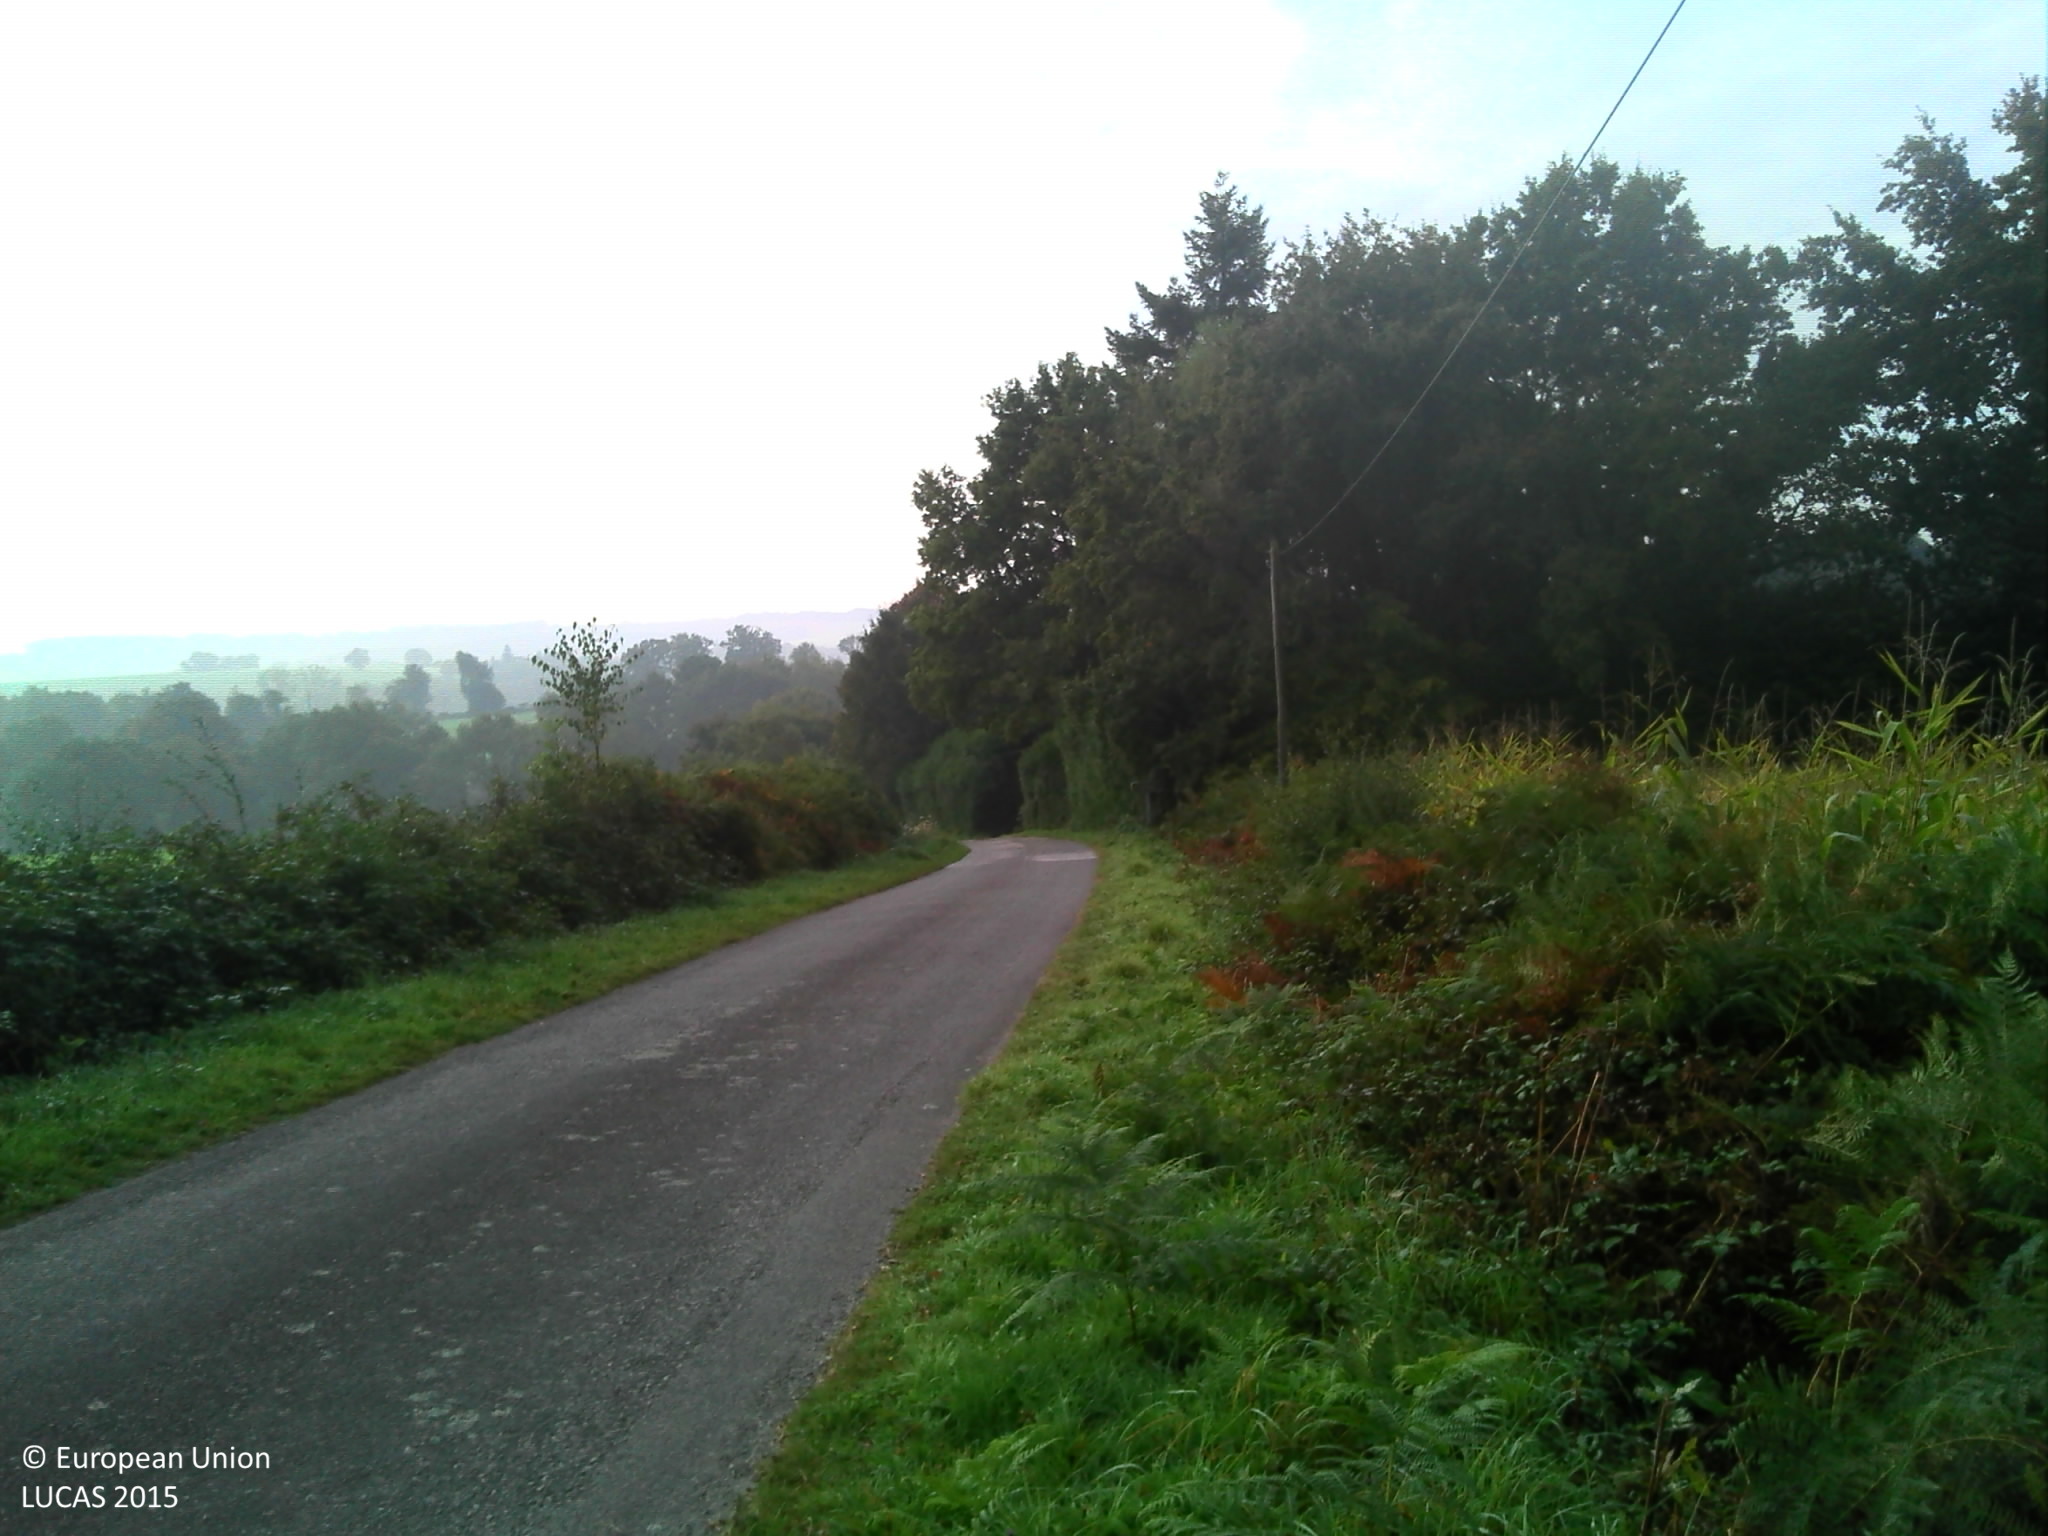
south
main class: Cropland
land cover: Maize
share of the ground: > 75 %
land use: Agriculture (excluding fallow land and kitchen gardens)
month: October
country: FR
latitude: 47.6246
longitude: -2.2831
